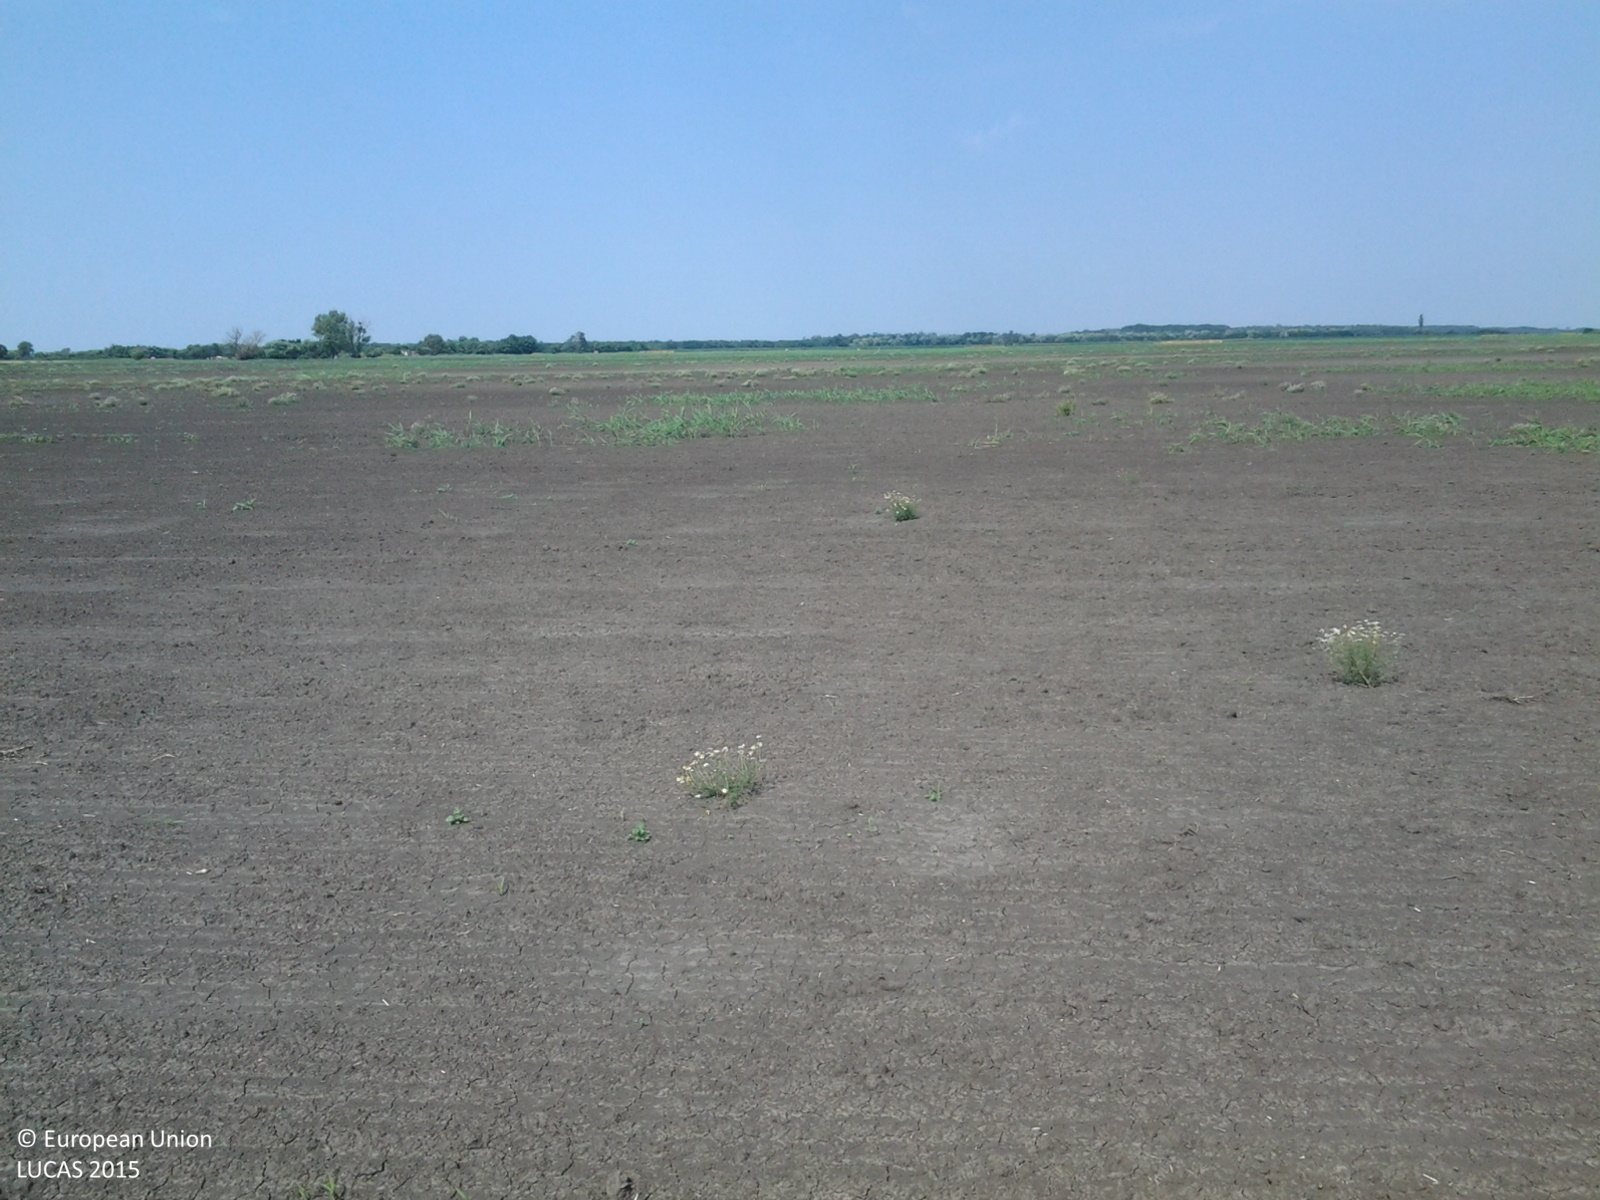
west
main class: Cropland
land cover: Maize
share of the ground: < 10 %
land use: Agriculture (excluding fallow land and kitchen gardens)
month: July
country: HU
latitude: 46.9812
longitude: 20.4535
